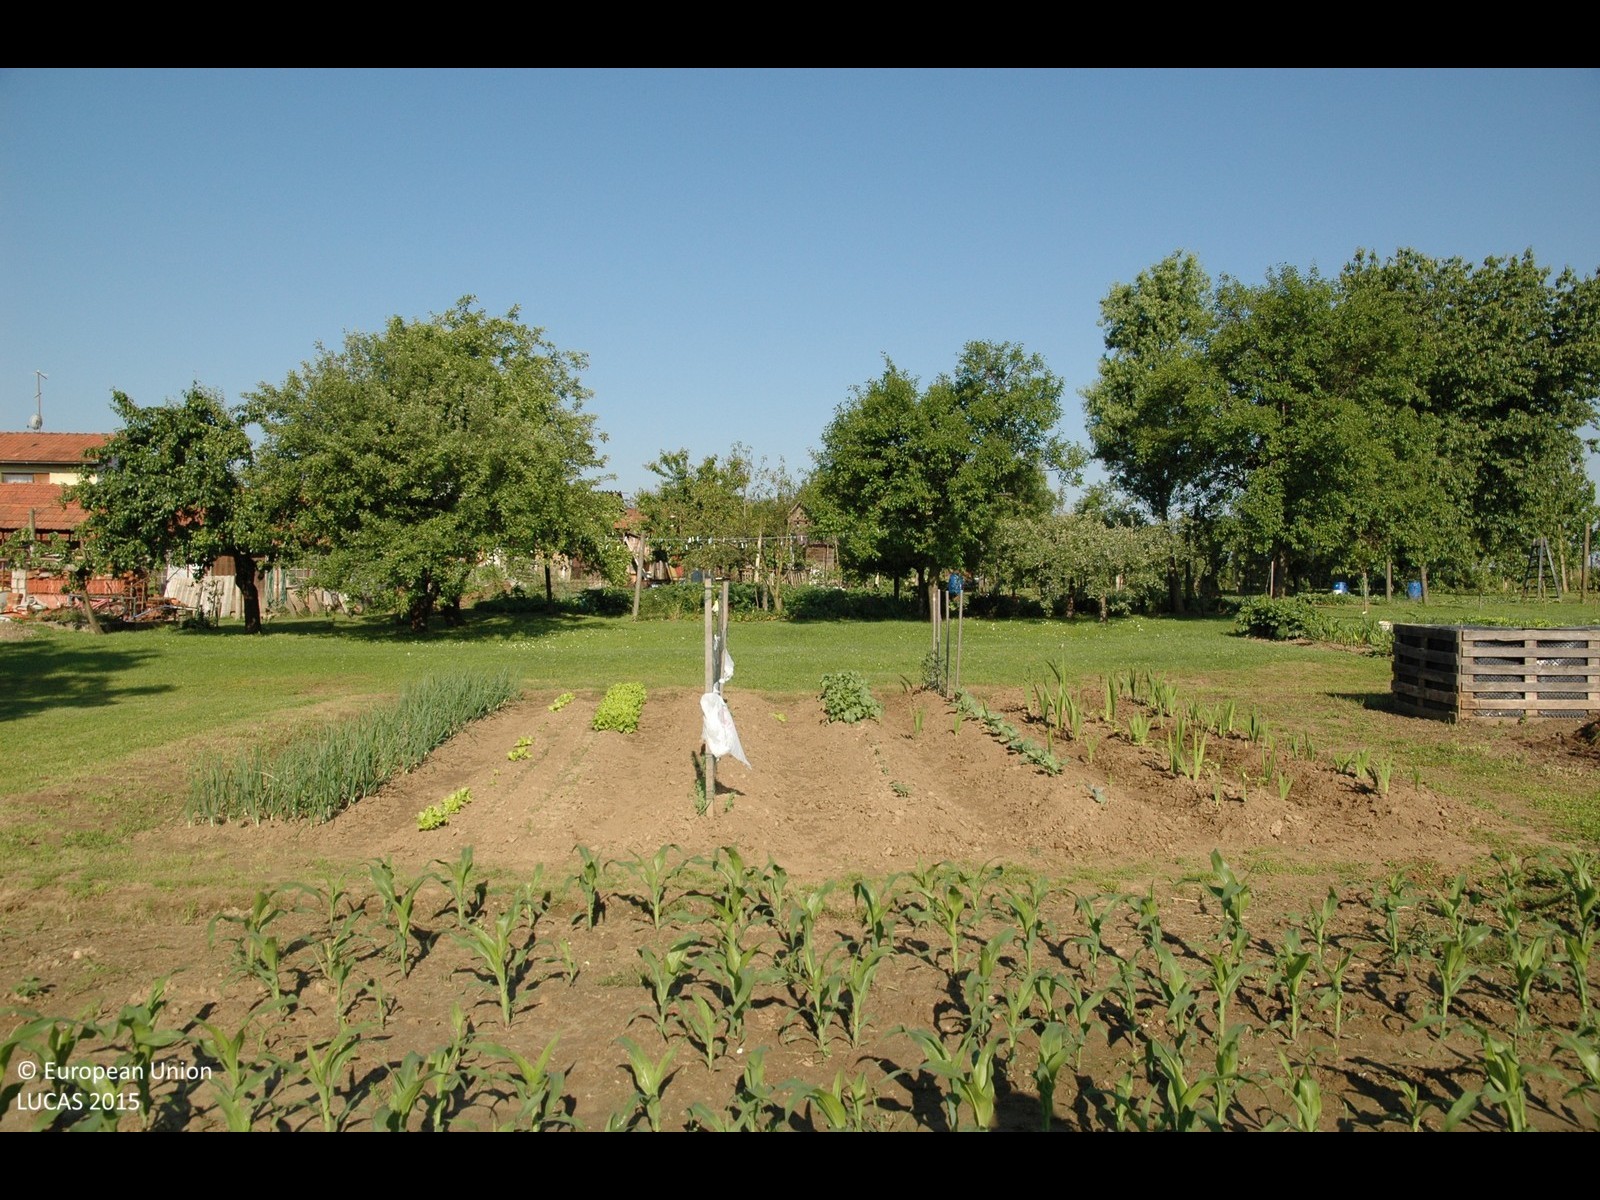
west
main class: Cropland
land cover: Maize
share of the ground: 25 - 50 %
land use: Agriculture (excluding fallow land and kitchen gardens)
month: May
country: HR
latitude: 46.4981
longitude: 16.4769
